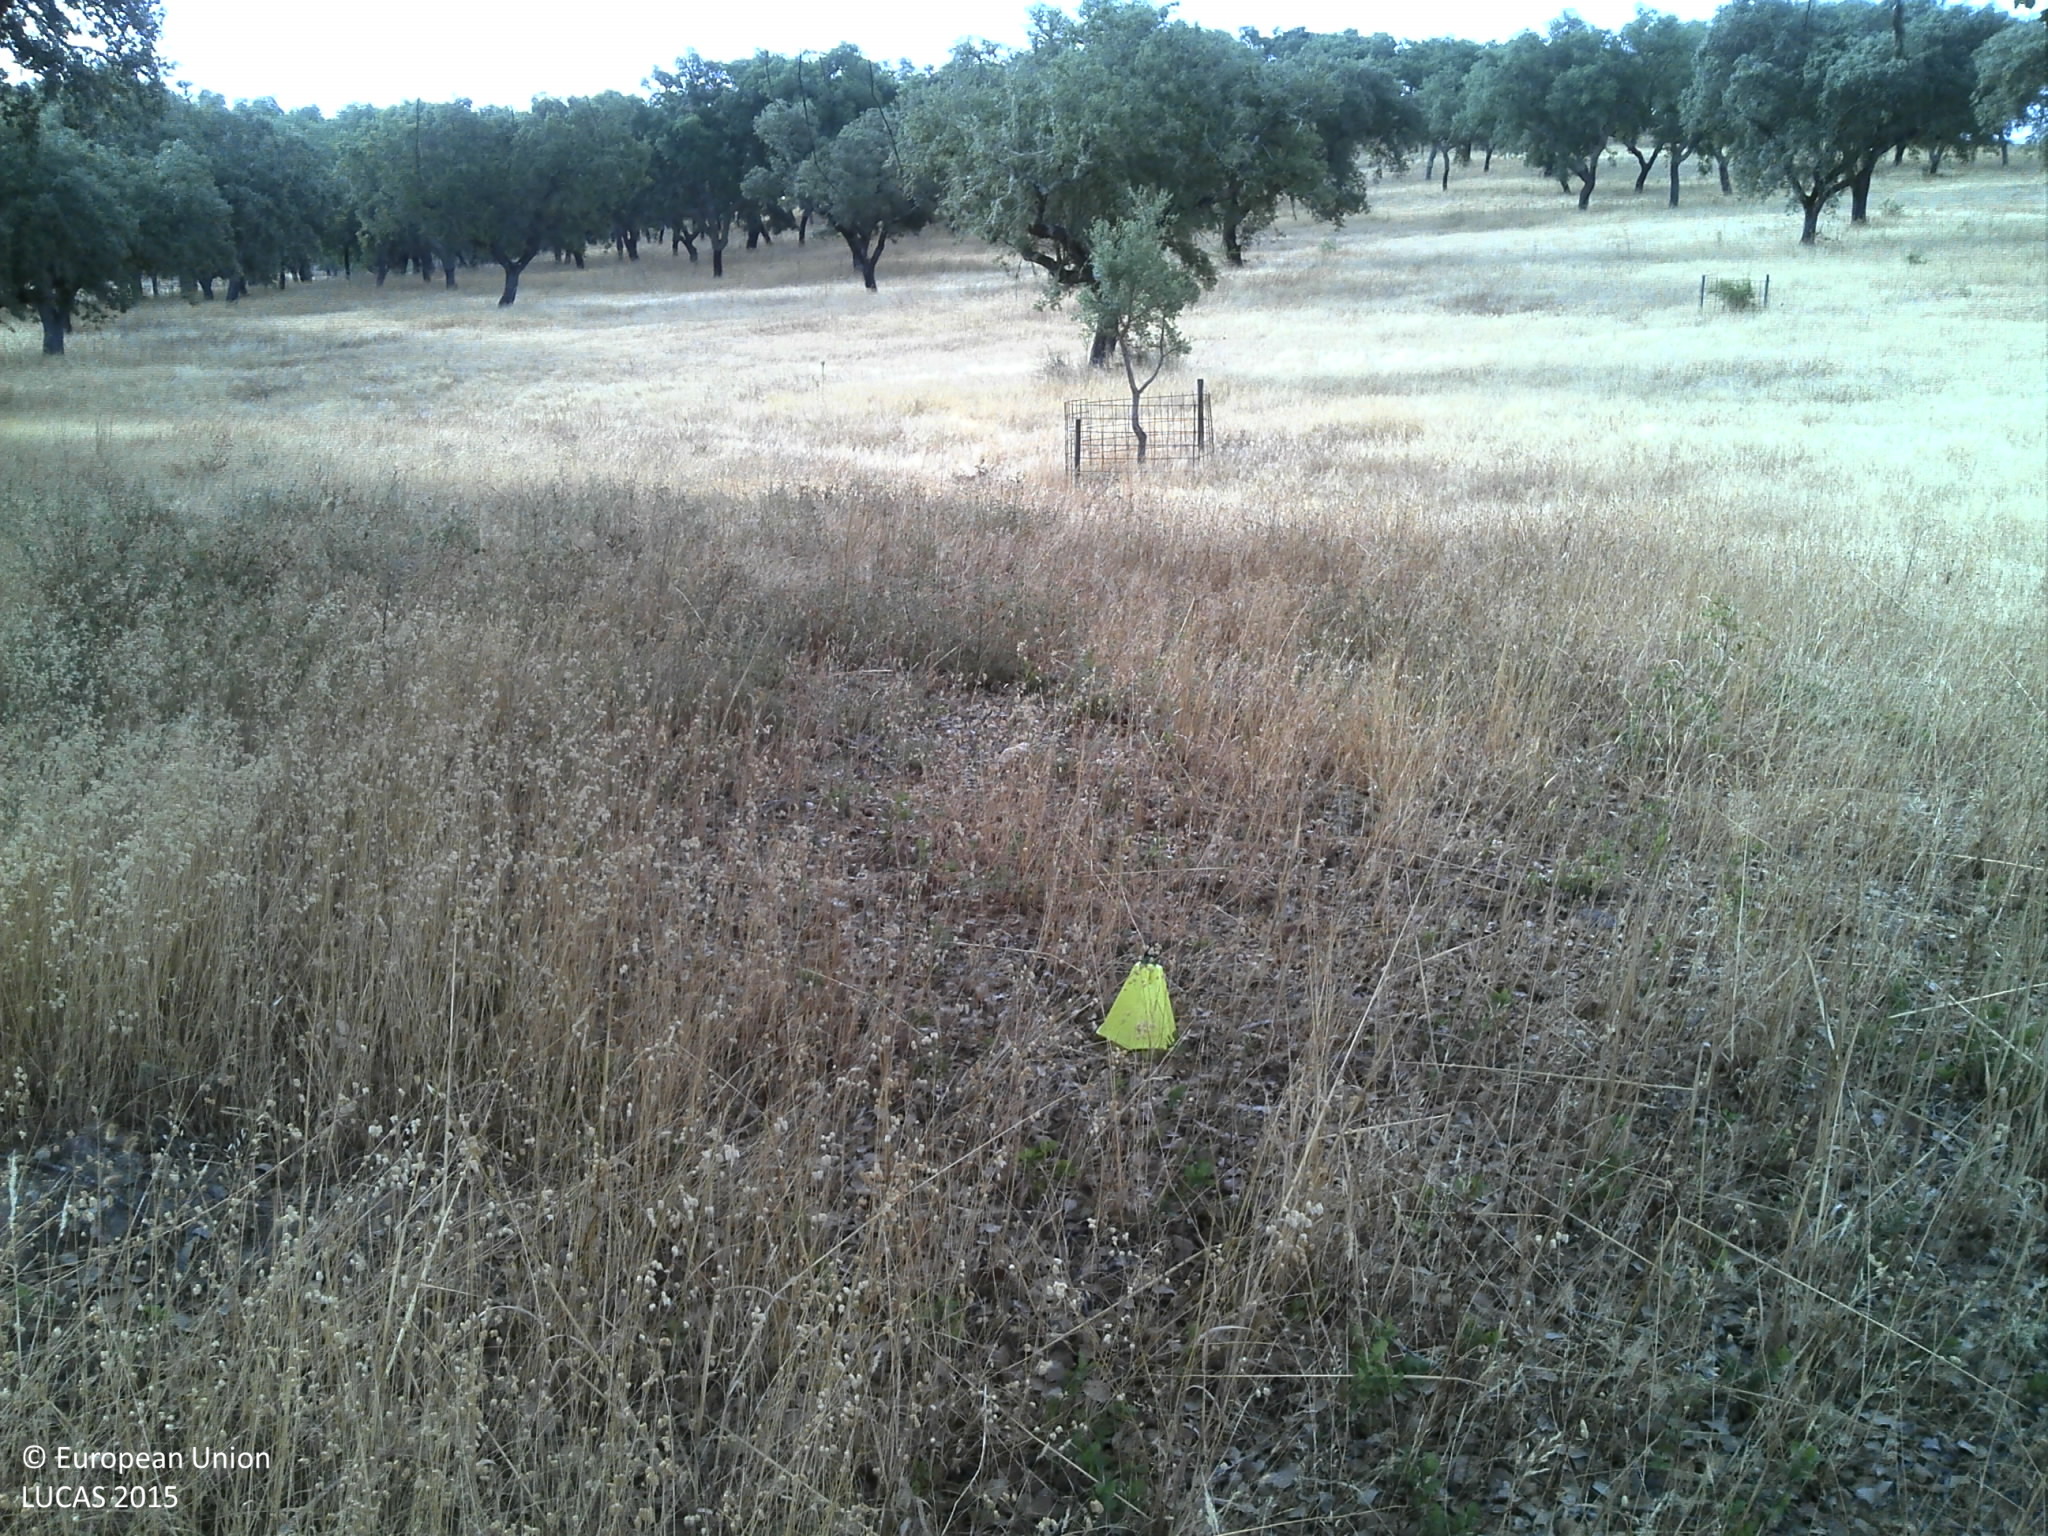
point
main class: Woodland
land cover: Broadleaved woodland
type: broadleaved evergreen forest
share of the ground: 25 - 50 %
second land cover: Grassland without tree/shrub cover
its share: 25 - 50 %
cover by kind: herbaceous plants 50 %, broadleaved forest trees 30 %, unconsolidated bare surface 20 %
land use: Forestry
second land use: Agriculture (excluding fallow land and kitchen gardens)
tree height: > 5 m
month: July
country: PT
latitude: 38.7281
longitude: -7.7412
